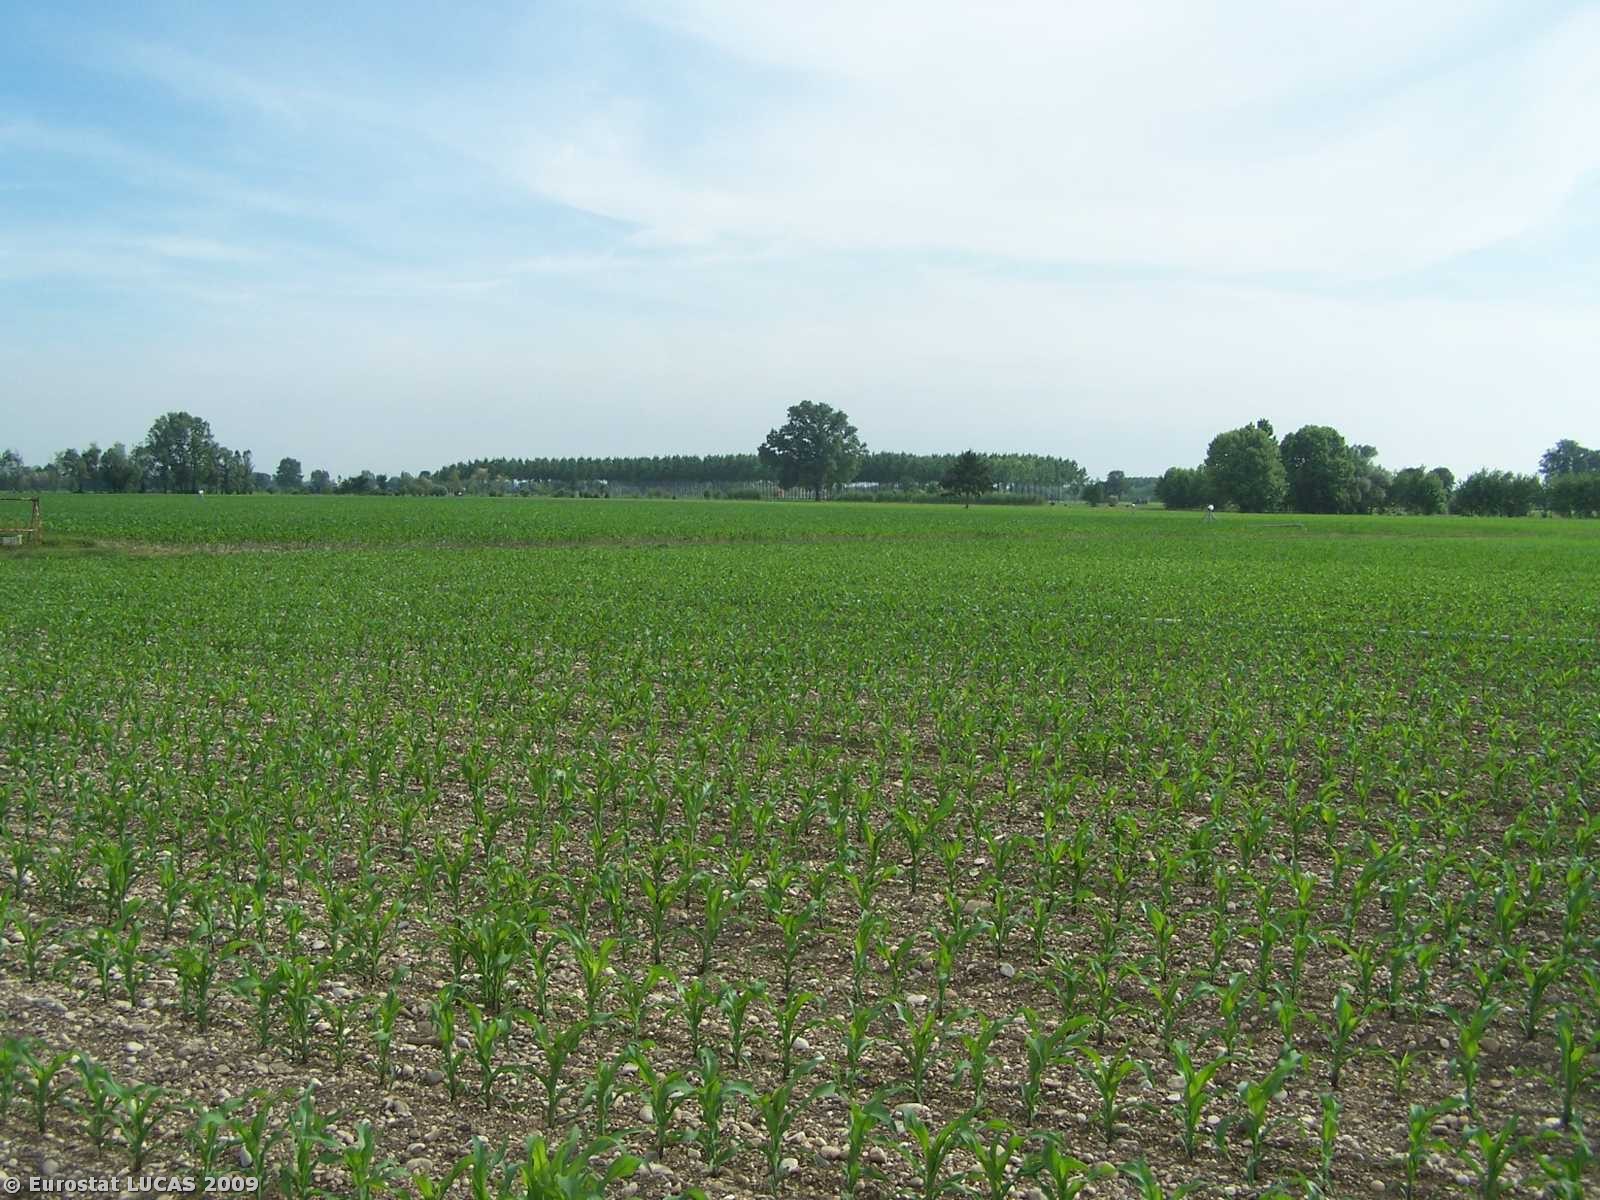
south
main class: Cropland
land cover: Maize
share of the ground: 25 - 50 %
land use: Agriculture (excluding fallow land and kitchen gardens)
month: May
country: IT
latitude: 45.9133
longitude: 12.9745
